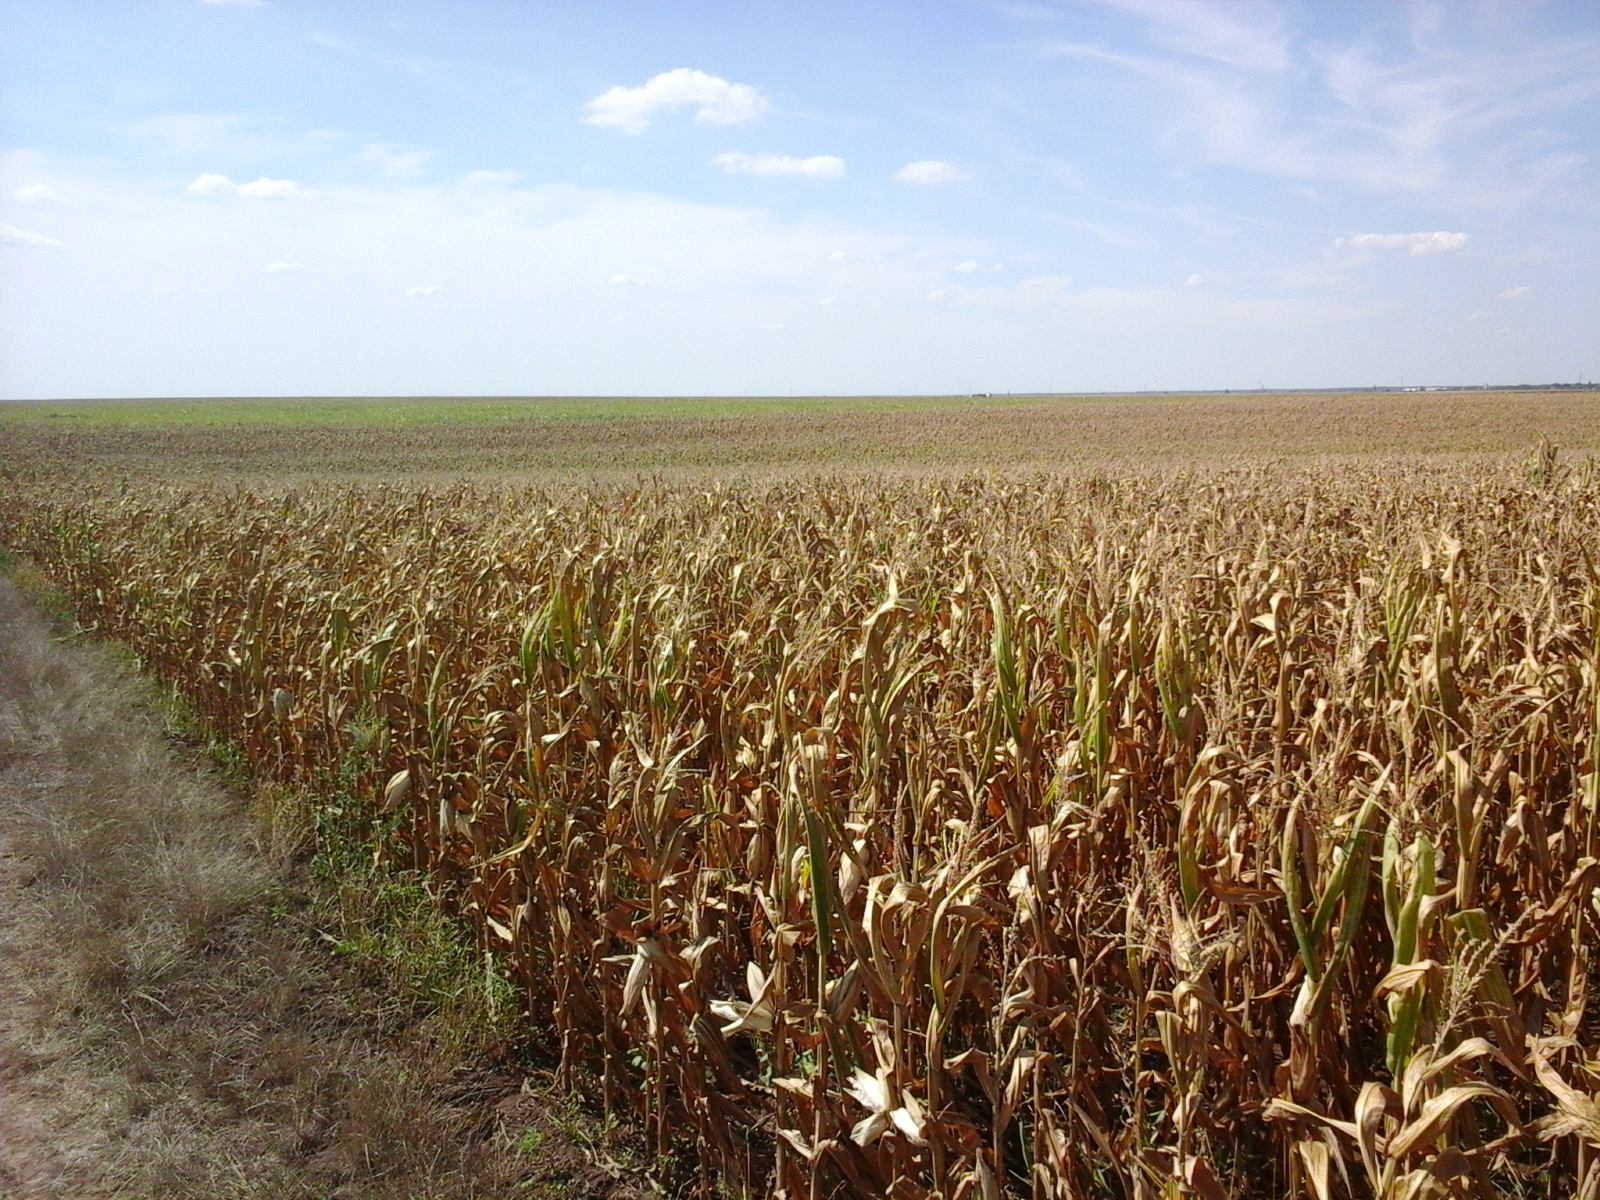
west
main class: Cropland
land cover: Maize
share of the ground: > 75 %
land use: Agriculture (excluding fallow land and kitchen gardens)
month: August
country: RO
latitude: 46.0916
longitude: 21.1677
